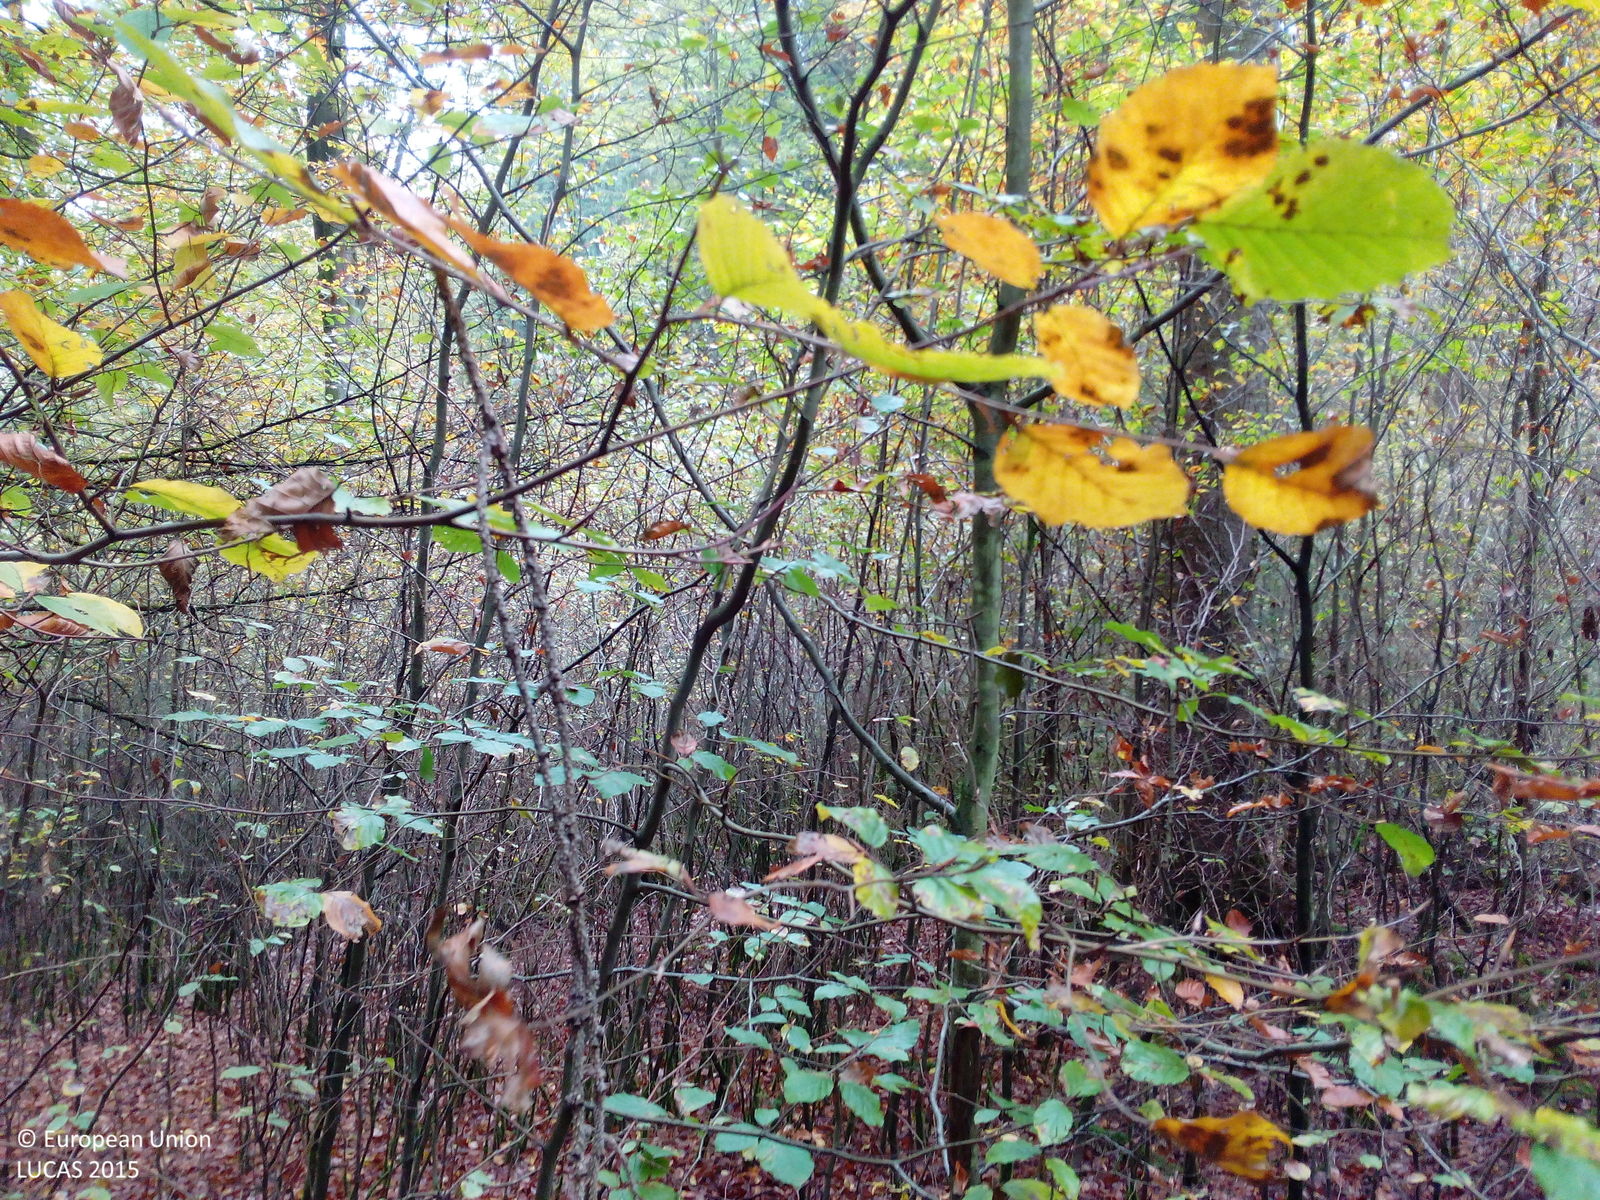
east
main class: Woodland
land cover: Spruce dominated mixed woodland
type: hemiboreal forest and nemoral coniferous forest and mixed broadleaved-coniferous forest
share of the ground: 50 - 75 %
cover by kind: broadleaved forest trees 40 %, coniferous forest trees 25 %, lichens and mosses 15 %, unconsolidated bare surface 10 %, shrubs 5 %, herbaceous plants 5 %
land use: Forestry
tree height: > 5 m
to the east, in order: Spruce dominated mixed woodland; Broadleaved woodland; Spruce dominated mixed woodland; Tracks; Spruce dominated mixed woodland; Spruce dominated coniferous woodland
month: October
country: DE
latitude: 50.2554
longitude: 9.5934
